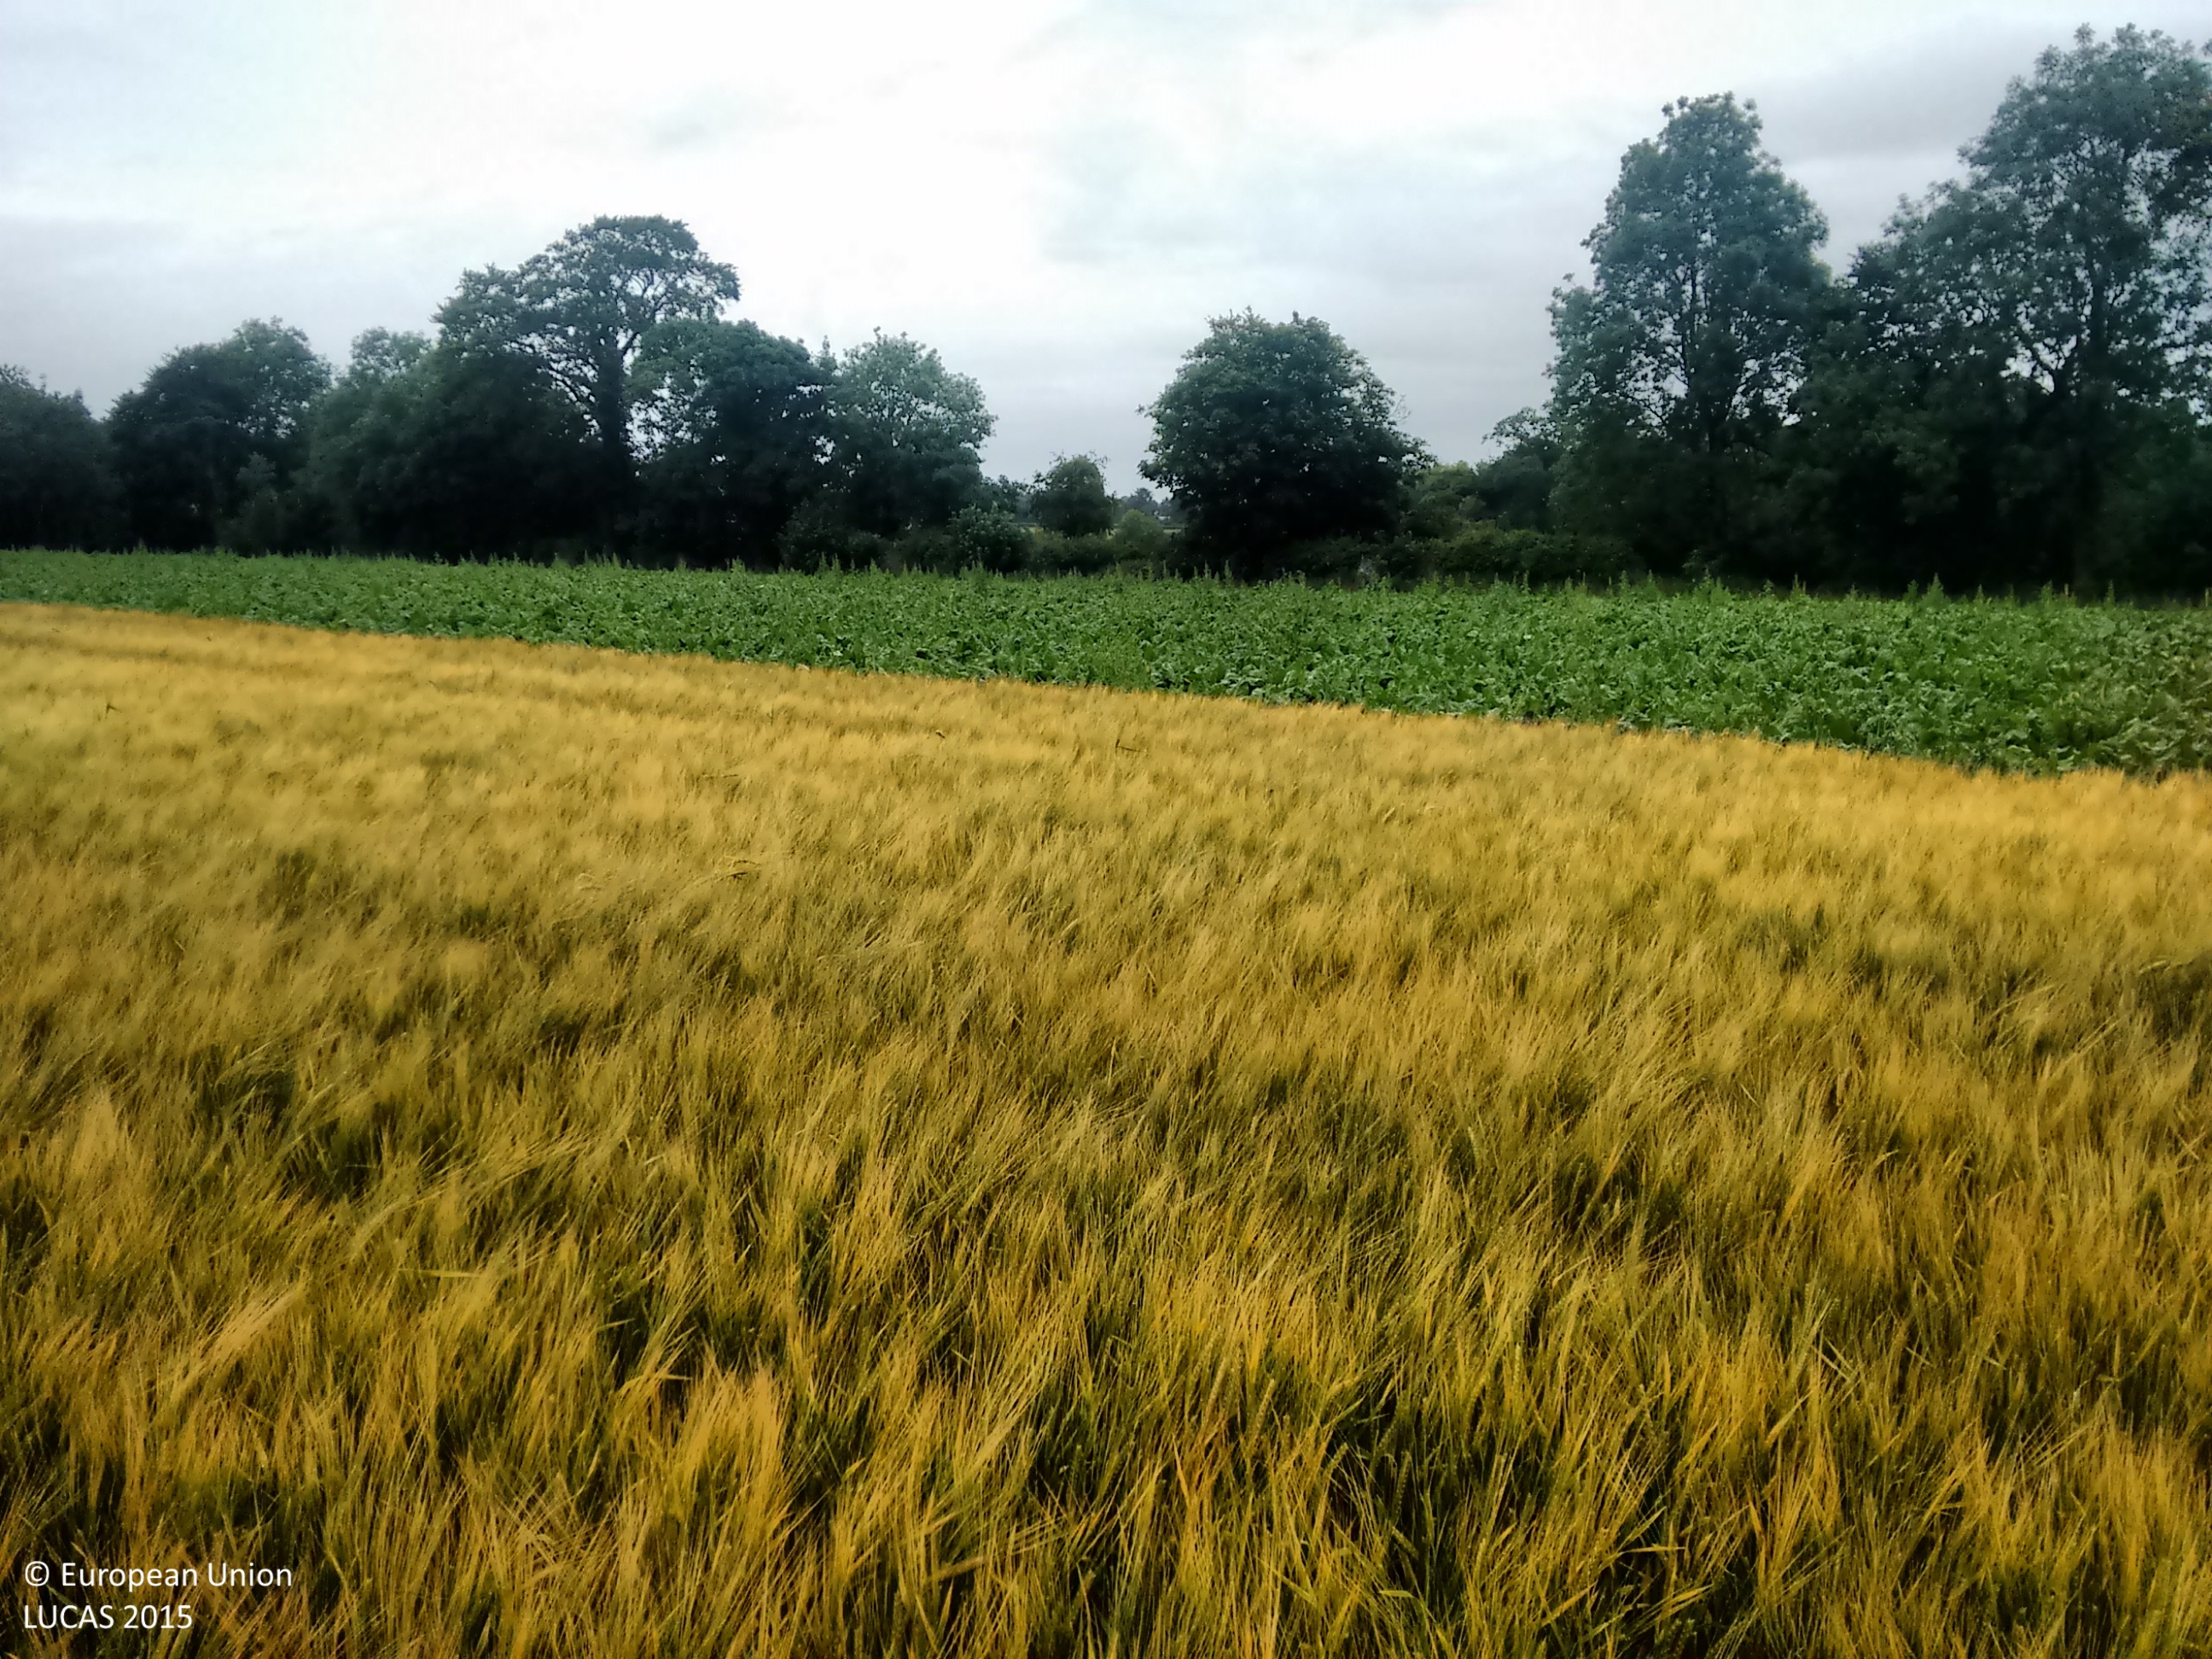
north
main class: Cropland
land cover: Barley
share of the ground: > 75 %
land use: Agriculture (excluding fallow land and kitchen gardens)
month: July
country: IE
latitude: 52.5035
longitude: -7.2244
